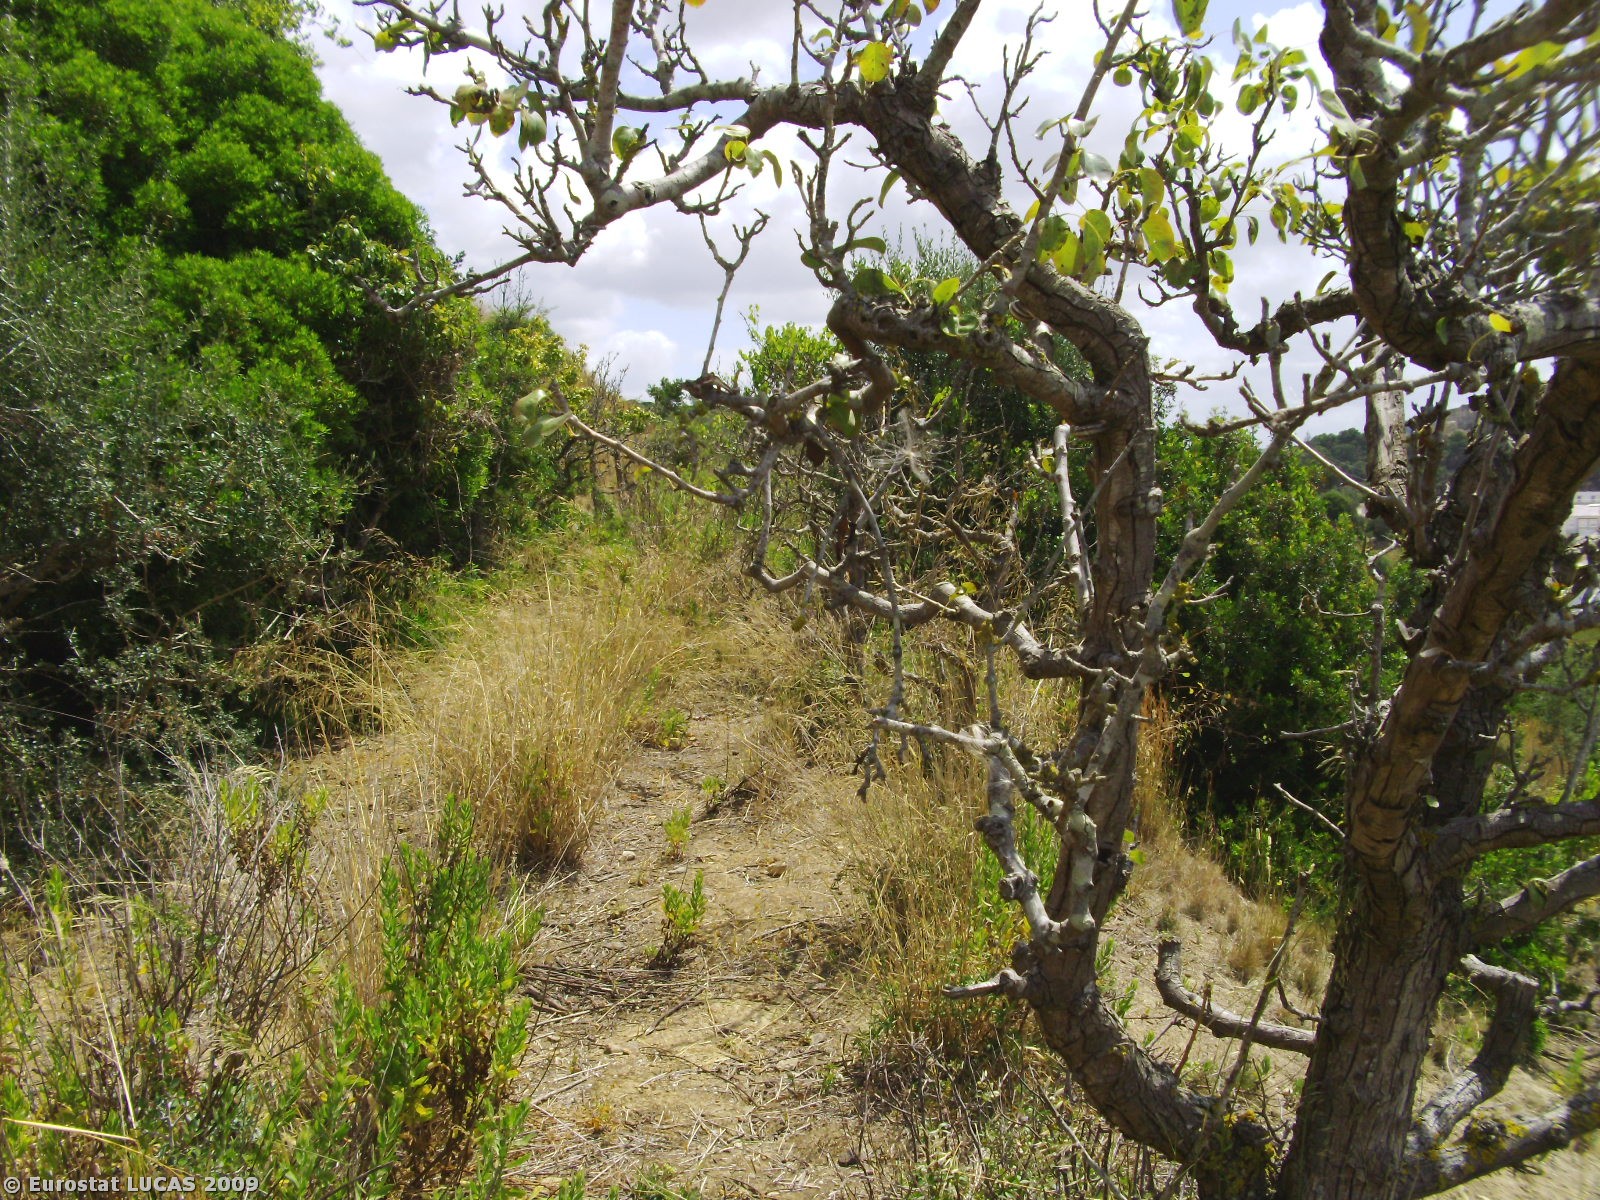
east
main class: Shrubland
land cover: Shrubland with sparse tree cover
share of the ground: 50 - 75 %
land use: Unused
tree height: < 5 m
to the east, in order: Shrubland with sparse tree cover; Shrubland without tree cover; Spontaneously vegetated surfaces; Mixed woodland; Lines of trees; Fences; Tracks; Shrubland with sparse tree cover
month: July
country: PT
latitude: 39.0968
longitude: -9.2688
